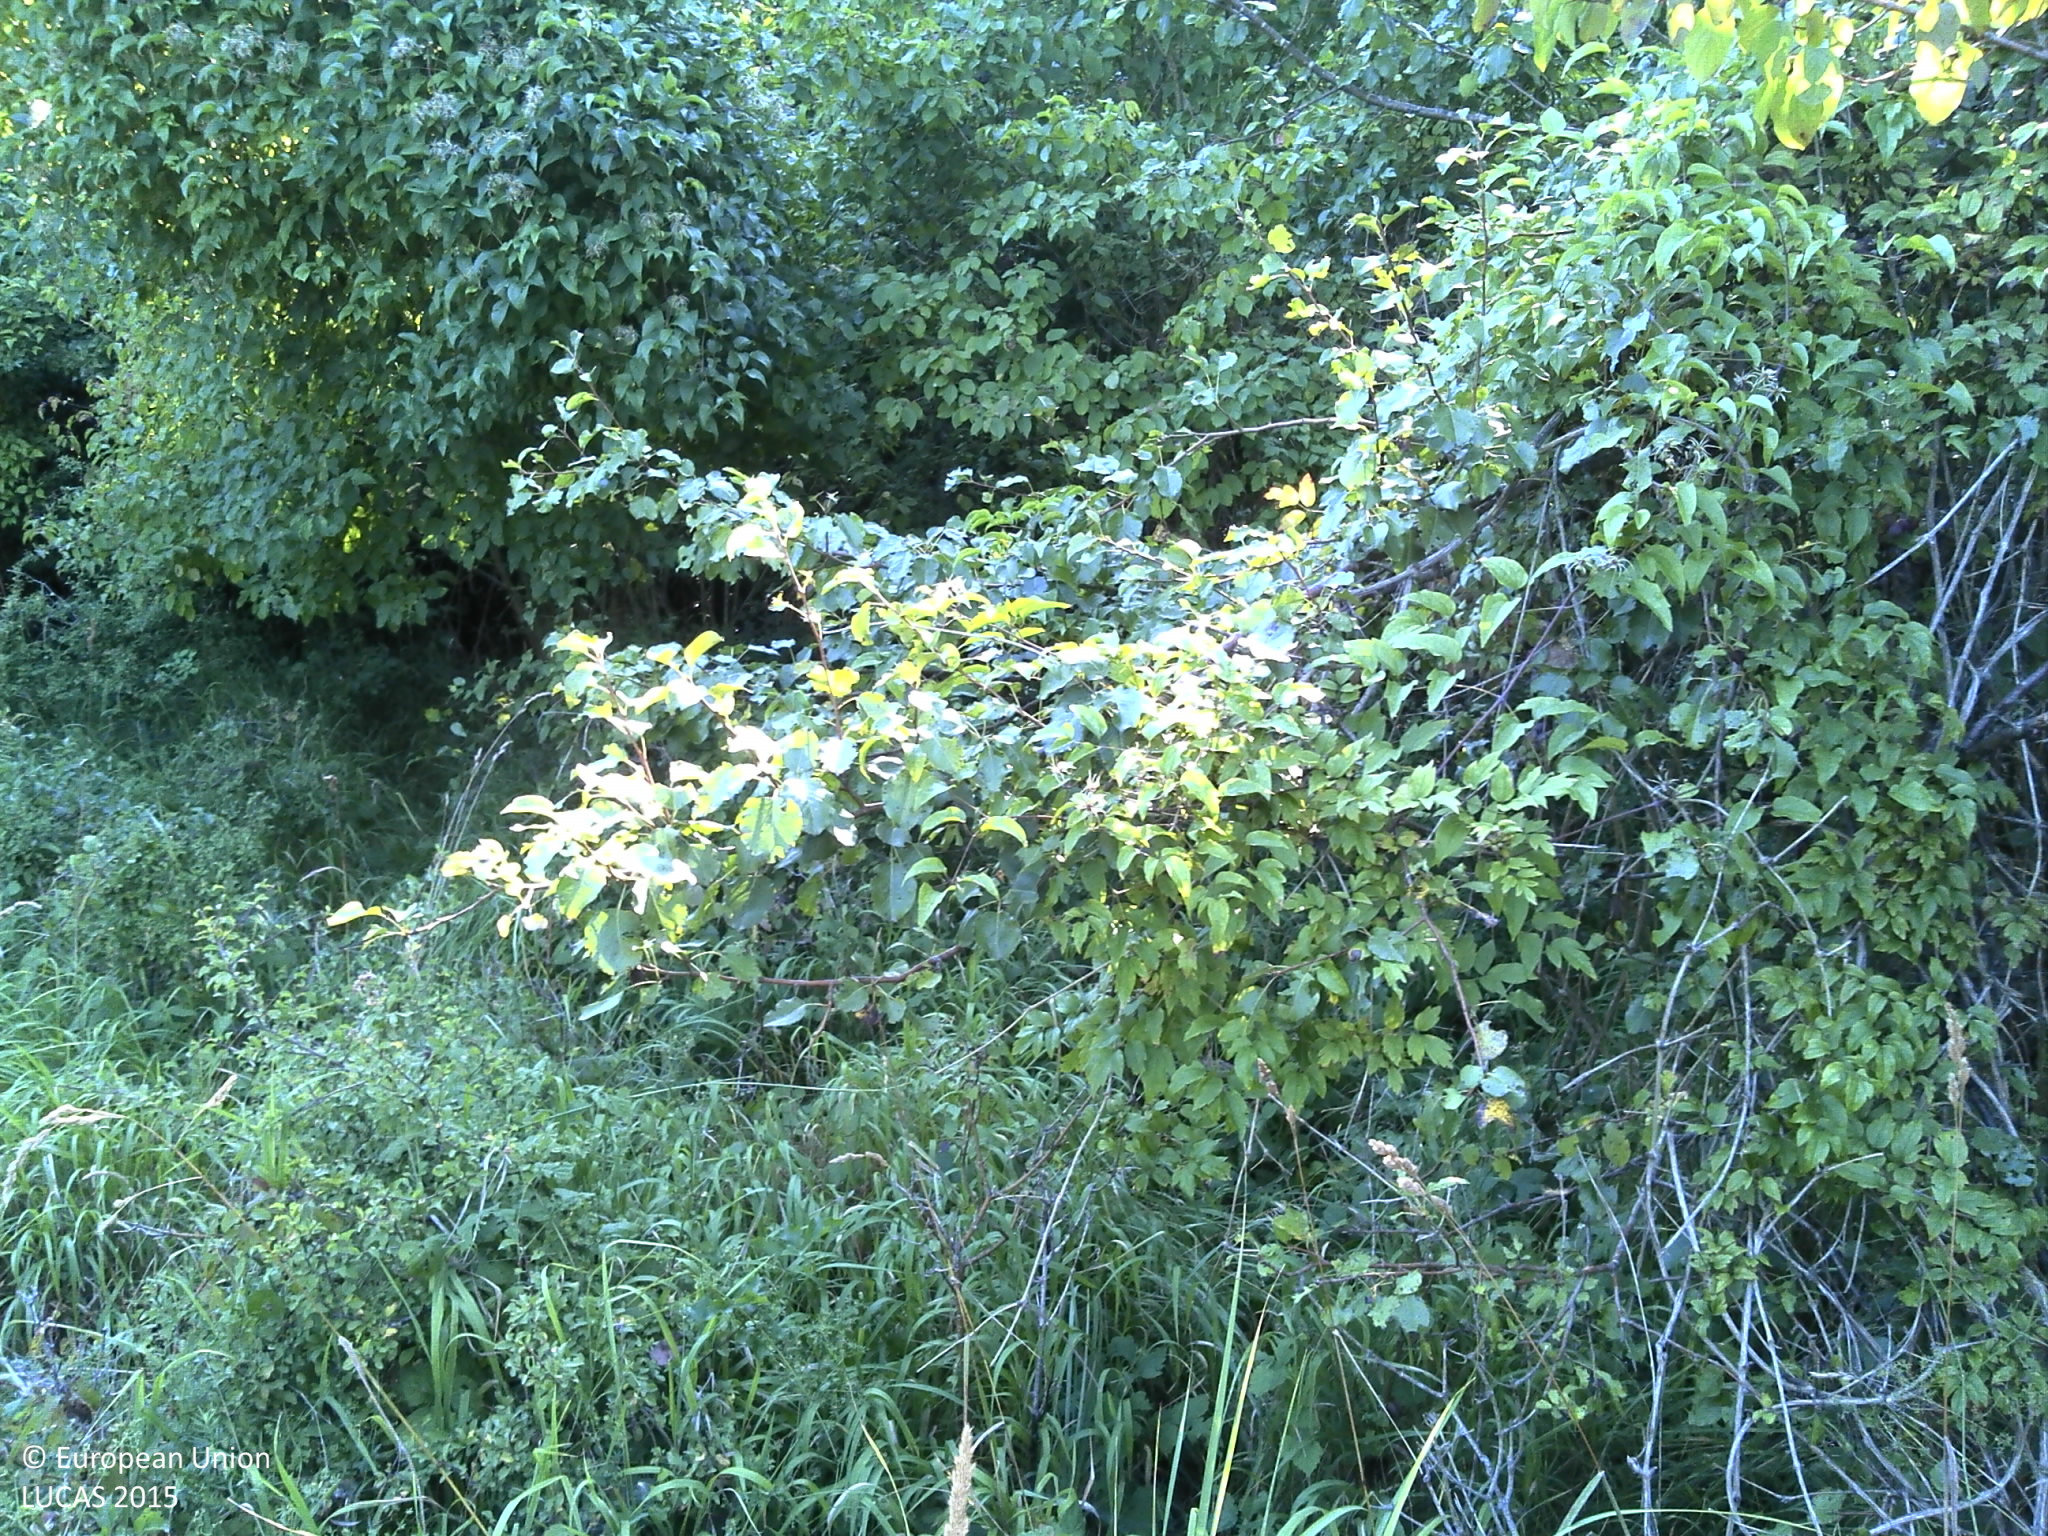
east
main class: Grassland
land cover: Spontaneously vegetated surfaces
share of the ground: > 75 %
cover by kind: herbaceous plants 100 %
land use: Semi-natural and natural areas not in use
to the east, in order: Spontaneously vegetated surfaces; Broadleaved woodland
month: August
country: HR
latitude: 45.5615
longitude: 17.2650
